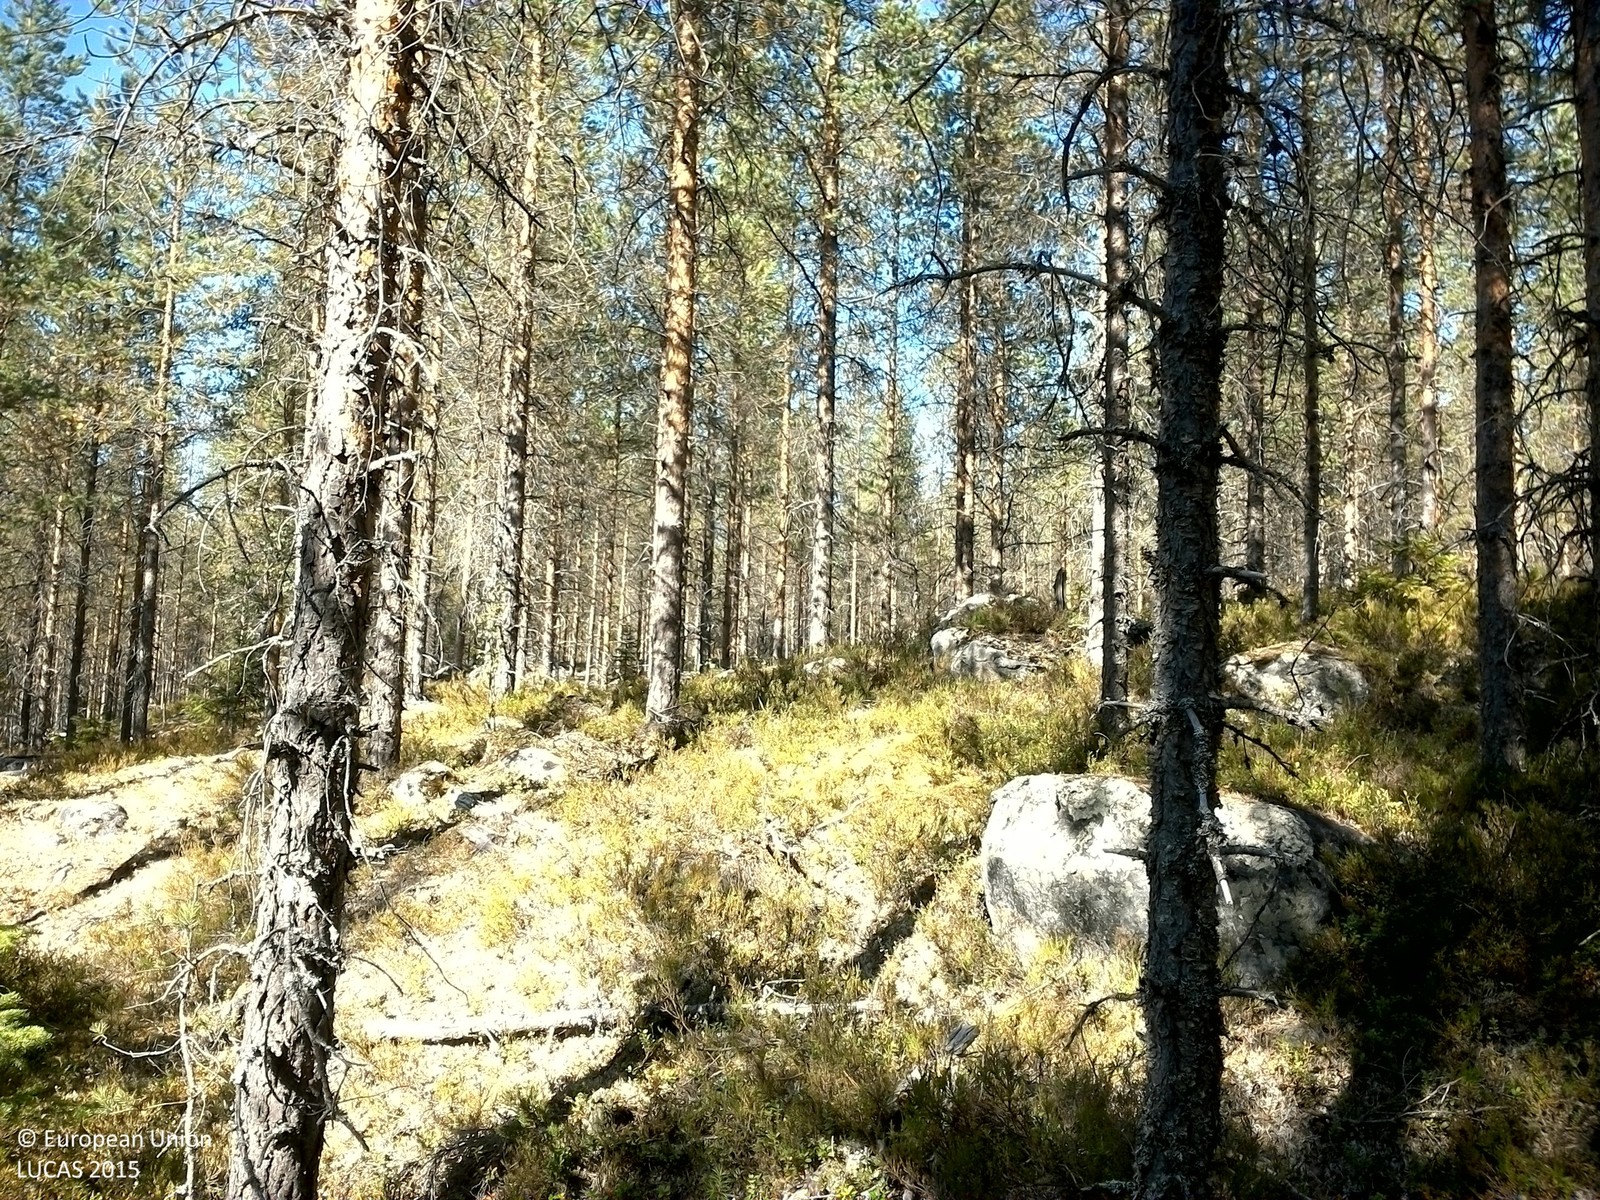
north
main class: Woodland
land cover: Pine dominated coniferous woodland
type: boreal forest
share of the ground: 50 - 75 %
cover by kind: coniferous forest trees 60 %, shrubs 20 %, lichens and mosses 15 %, broadleaved forest trees 5 %
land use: Forestry
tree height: > 5 m
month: August
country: SE
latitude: 63.6438
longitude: 17.4228
